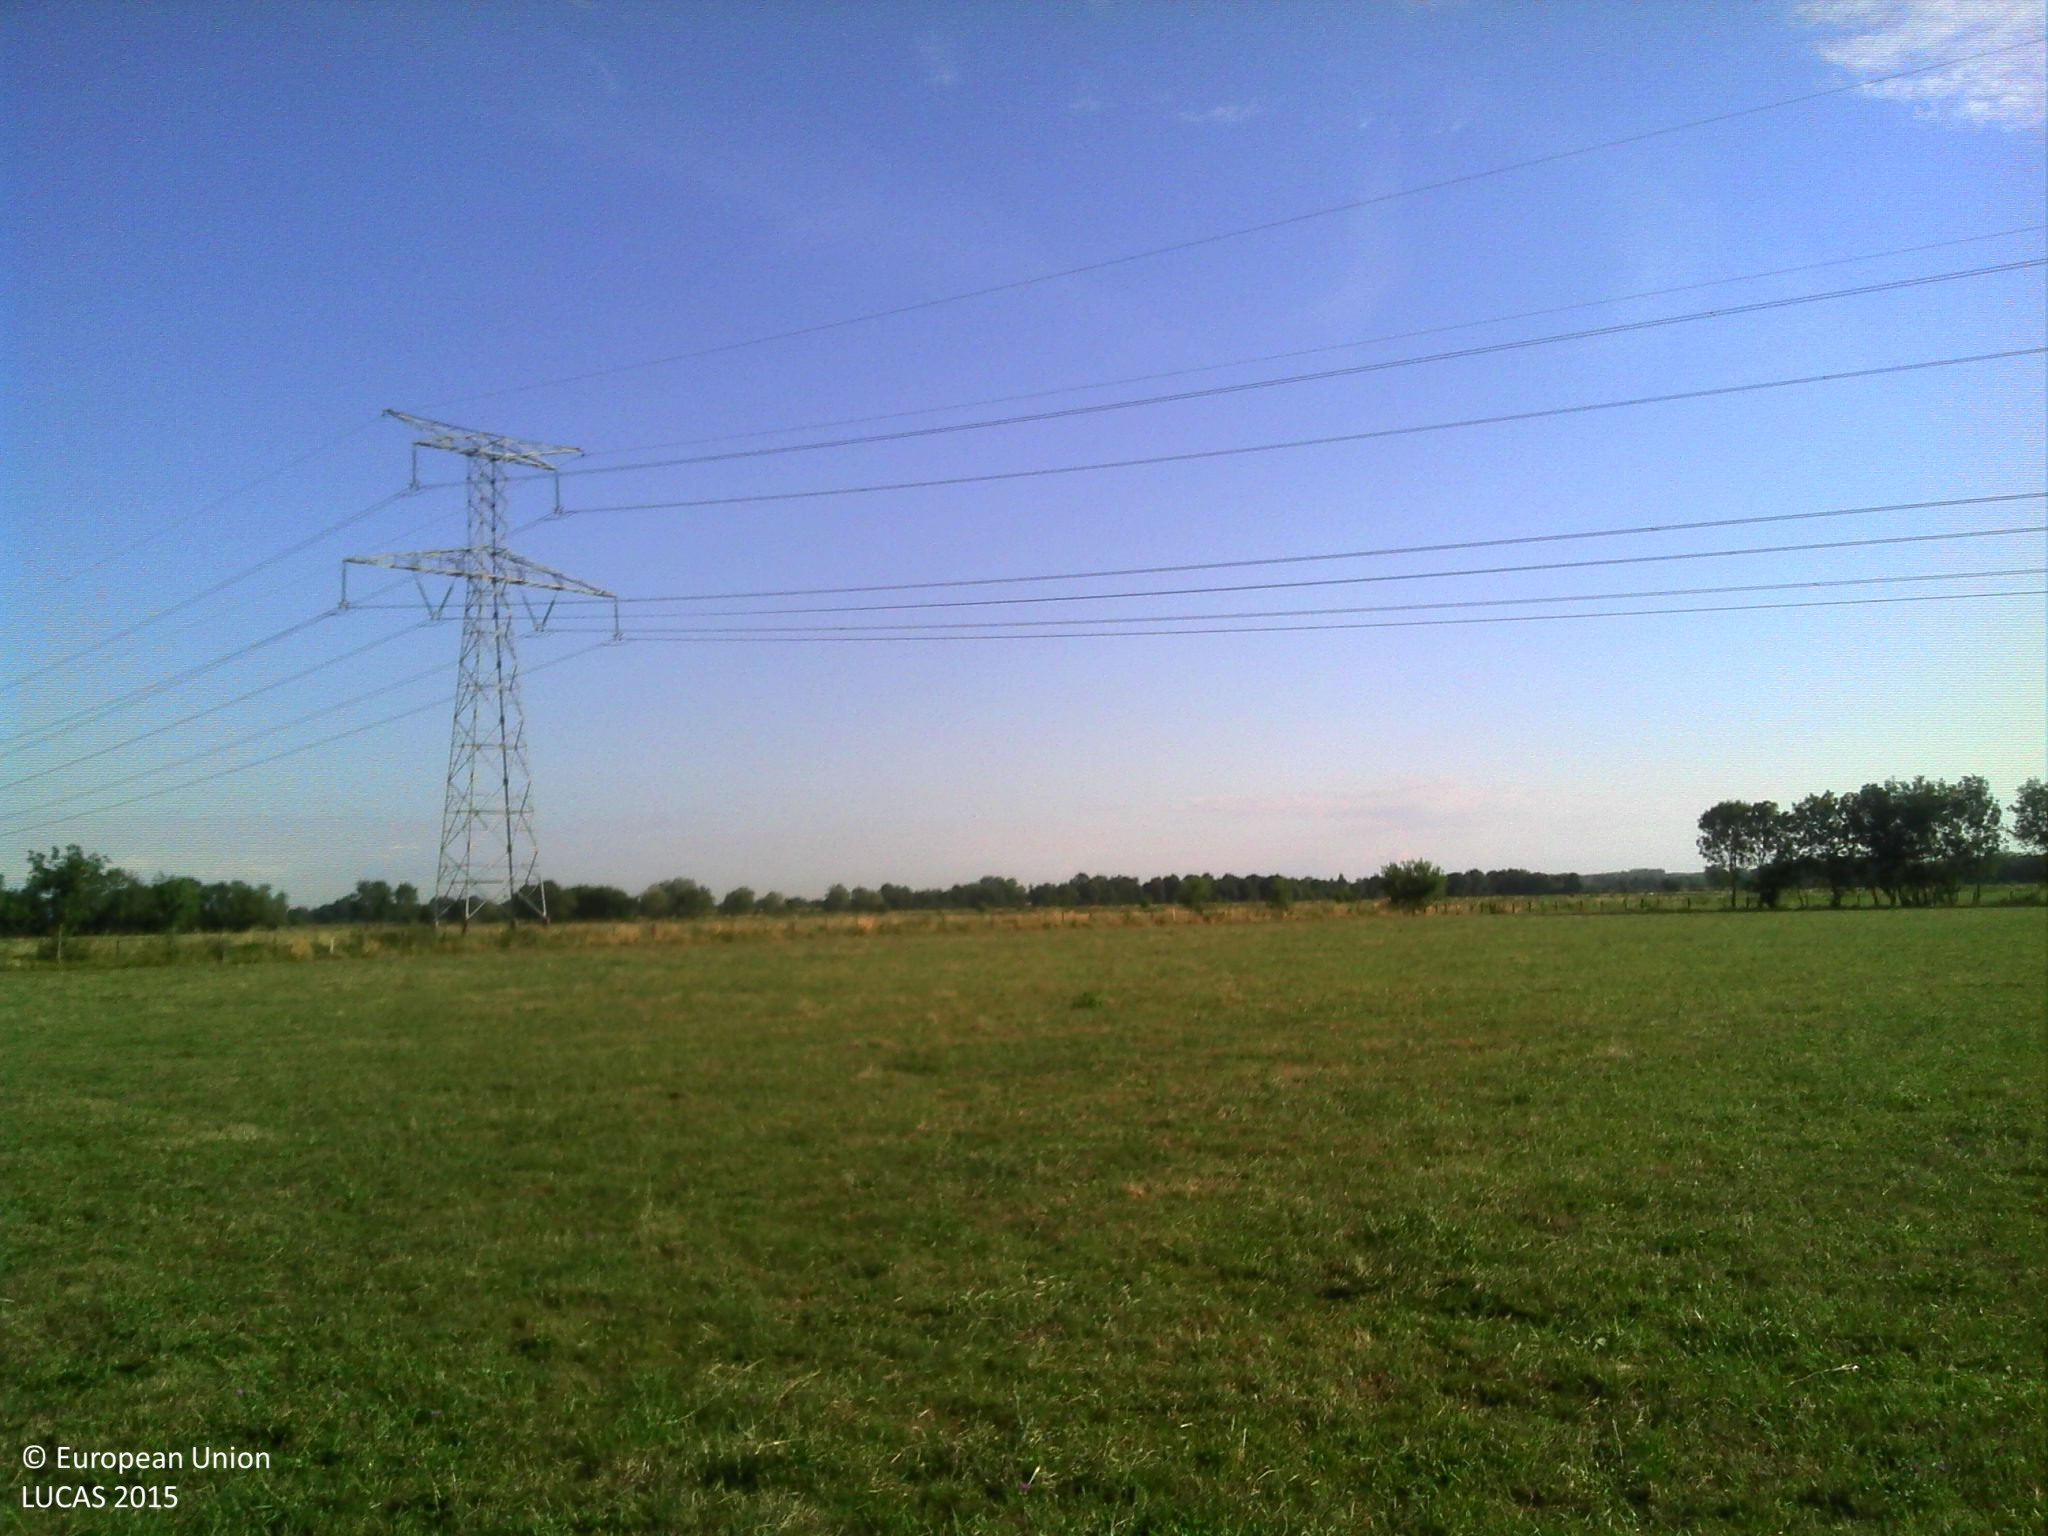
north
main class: Grassland
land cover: Grassland without tree/shrub cover
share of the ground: > 75 %
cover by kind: herbaceous plants 100 %
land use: Agriculture (excluding fallow land and kitchen gardens)
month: July
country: FR
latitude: 46.7161
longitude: 4.8864
